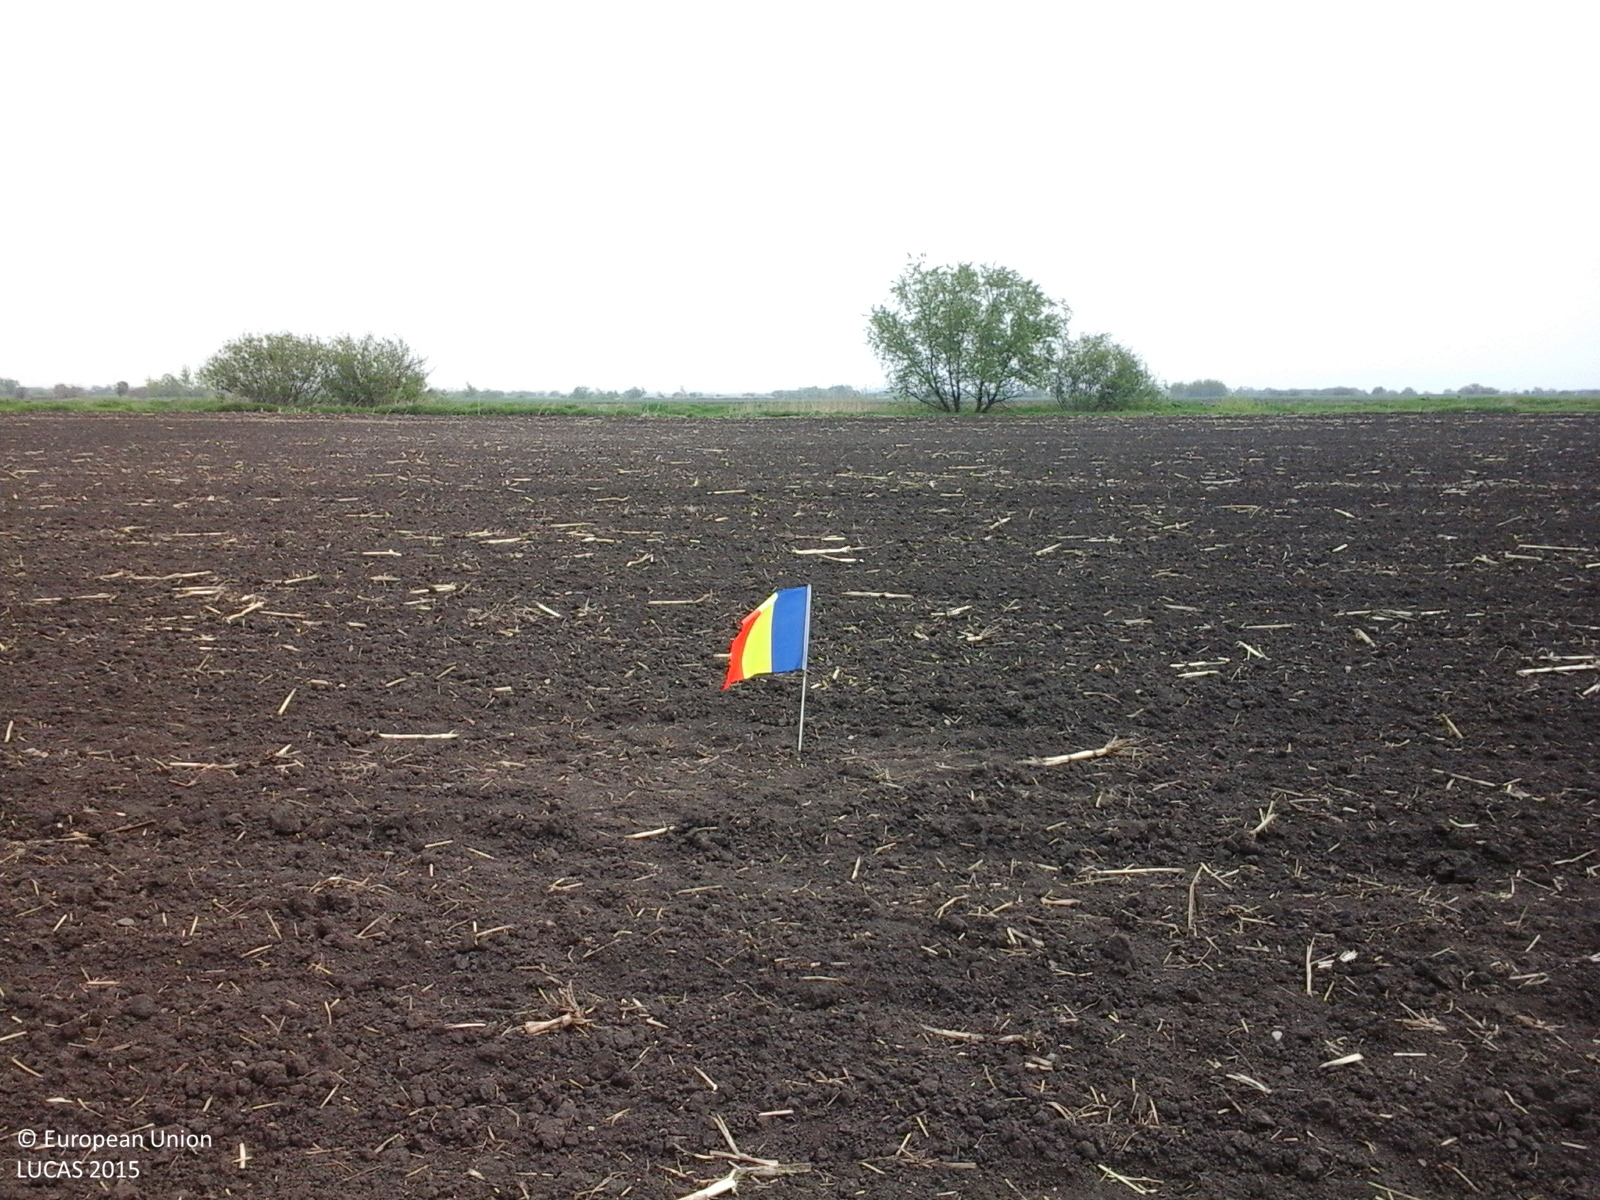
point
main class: Cropland
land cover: Maize
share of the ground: < 10 %
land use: Agriculture (excluding fallow land and kitchen gardens)
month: May
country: RO
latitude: 45.7246
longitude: 25.5087
